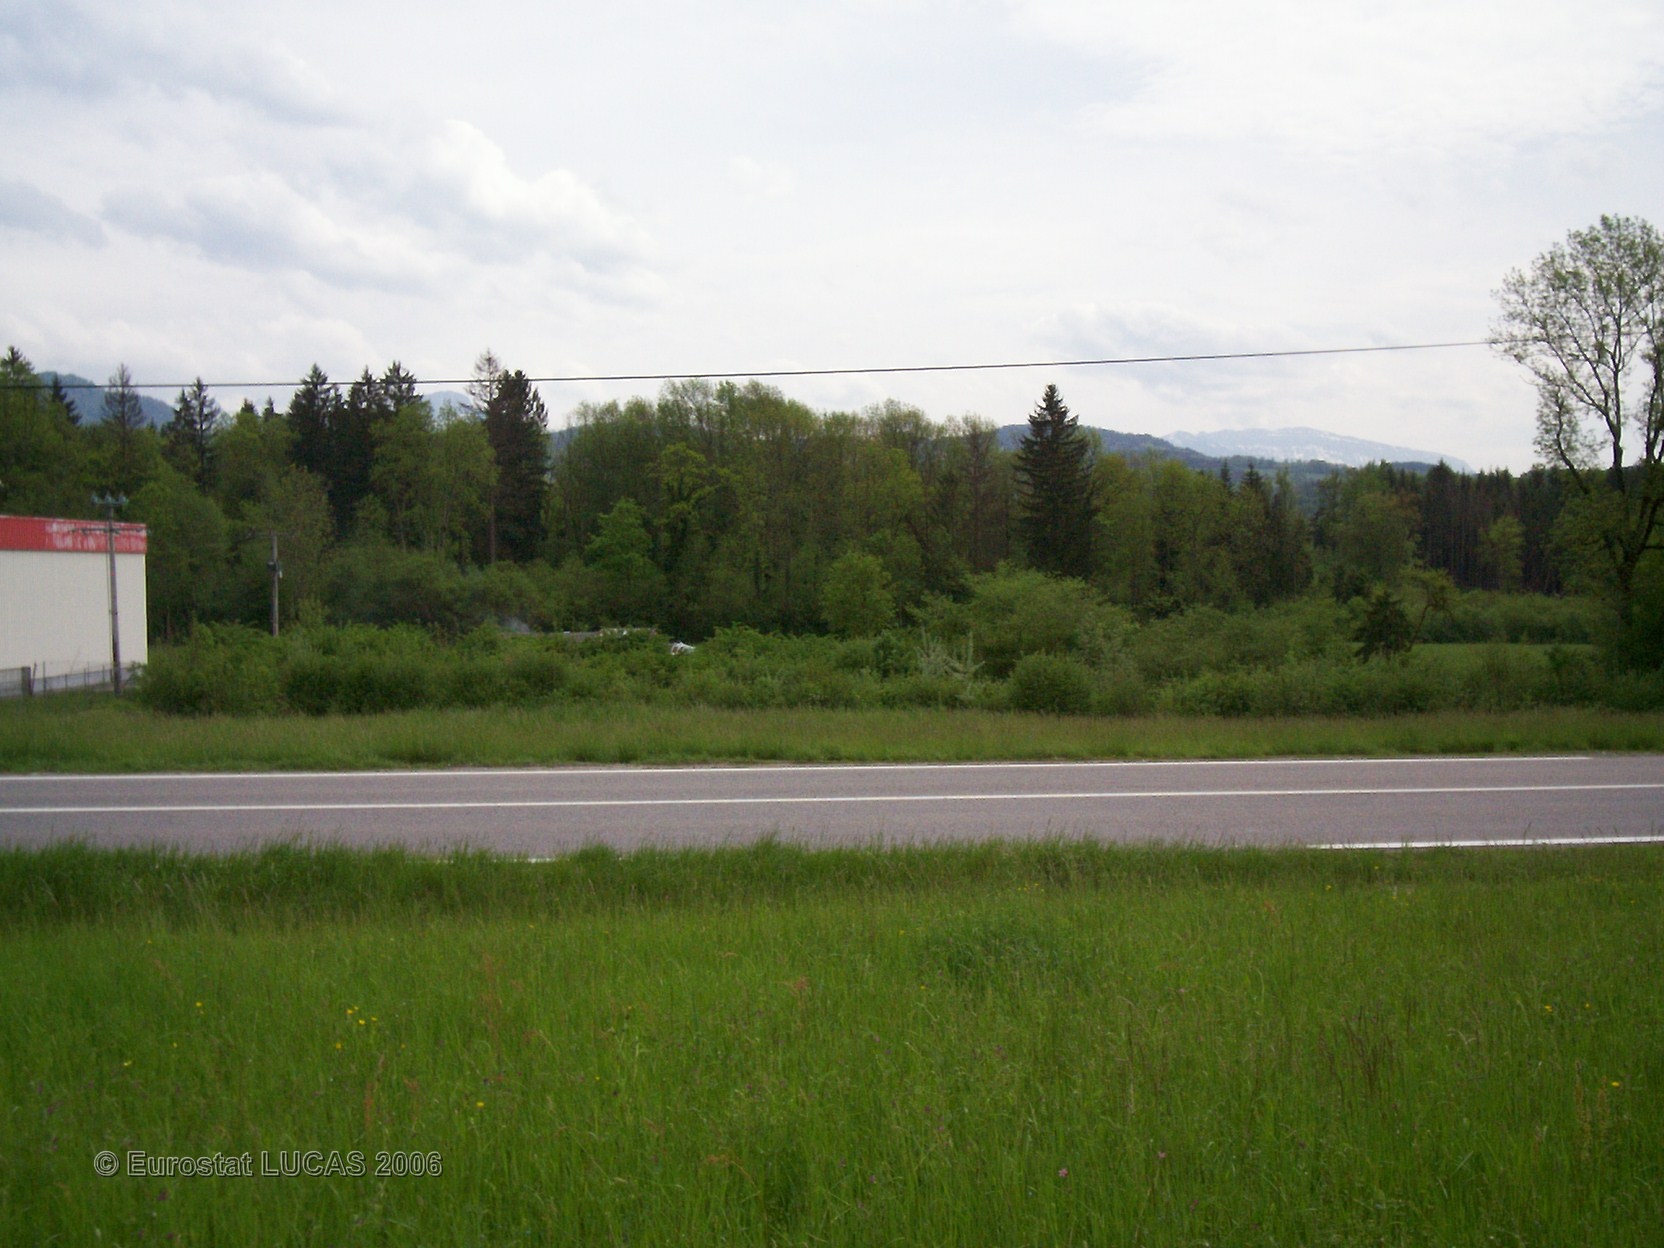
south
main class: Grassland
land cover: Grassland without tree/shrub cover
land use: Agriculture (excluding fallow land and kitchen gardens)
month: May
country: FR
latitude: 46.1461
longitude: 6.3915
